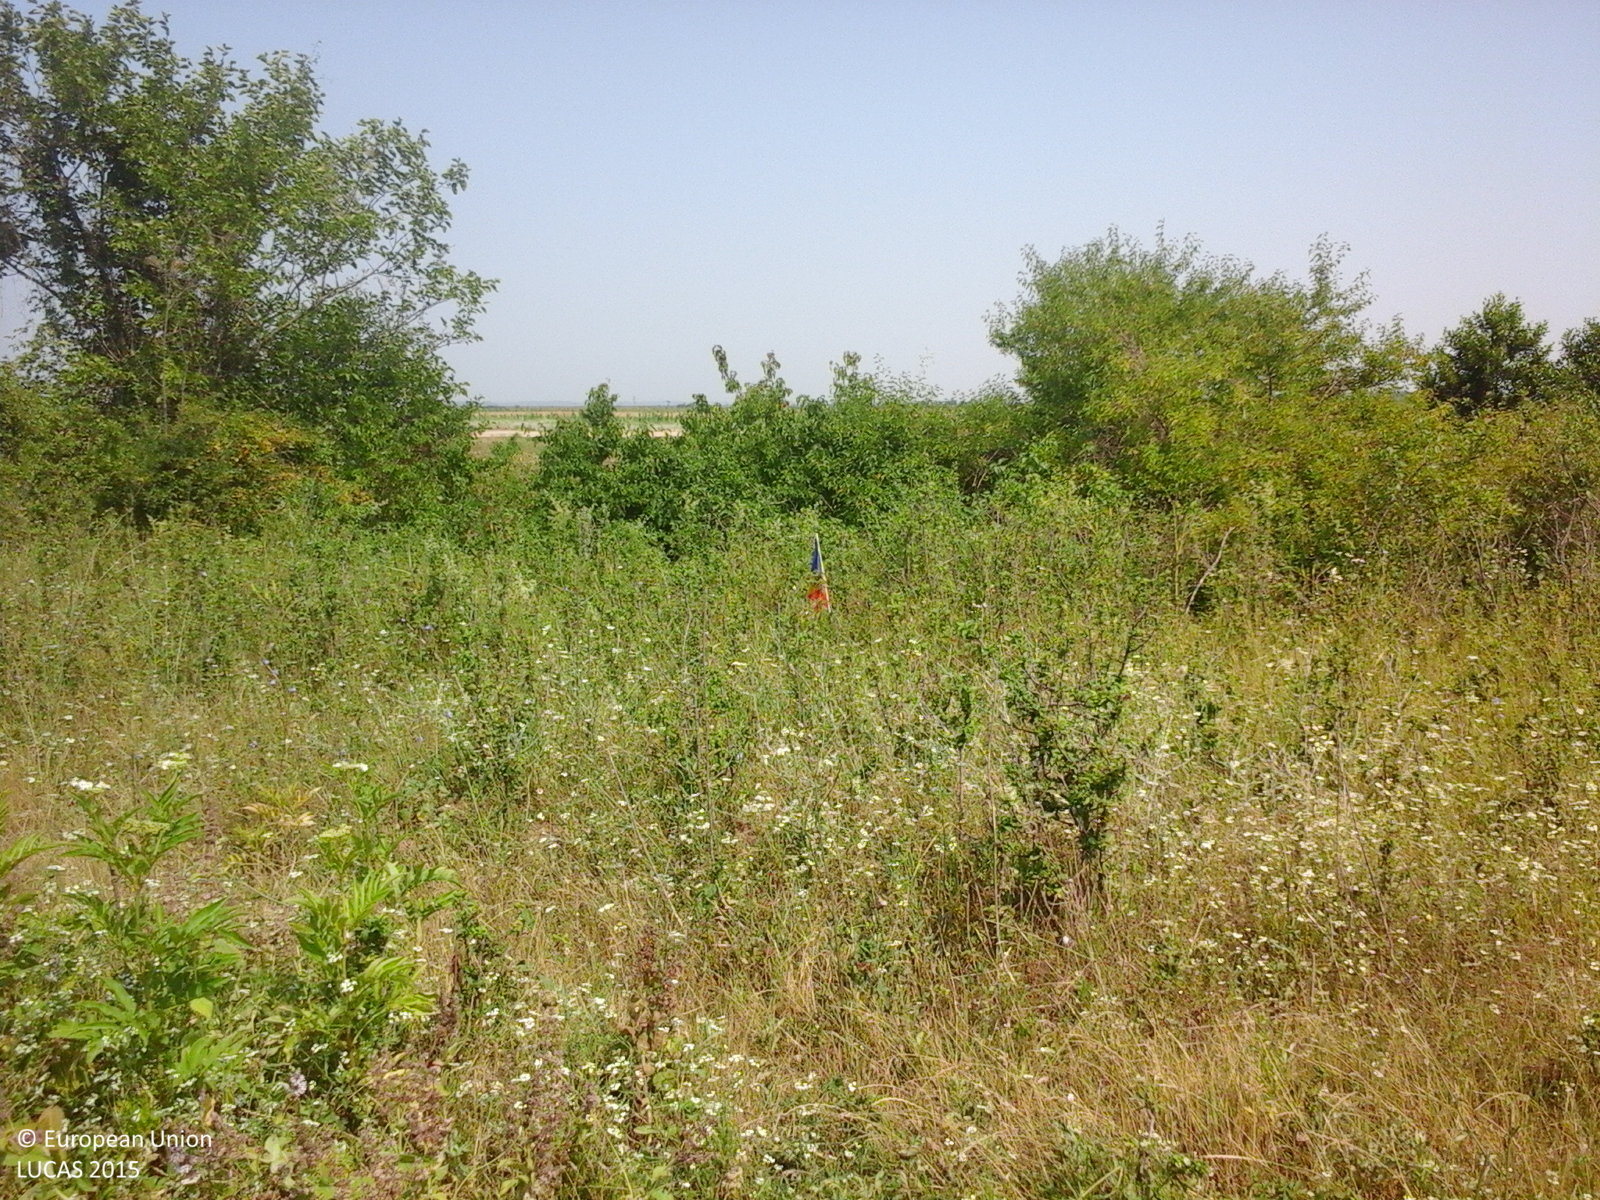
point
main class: Grassland
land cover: Grassland with sparse tree/shrub cover
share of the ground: > 75 %
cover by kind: herbaceous plants 95 %, broadleaved forest trees 5 %
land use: Agriculture (excluding fallow land and kitchen gardens)
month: July
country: RO
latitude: 44.5736
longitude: 25.7253
